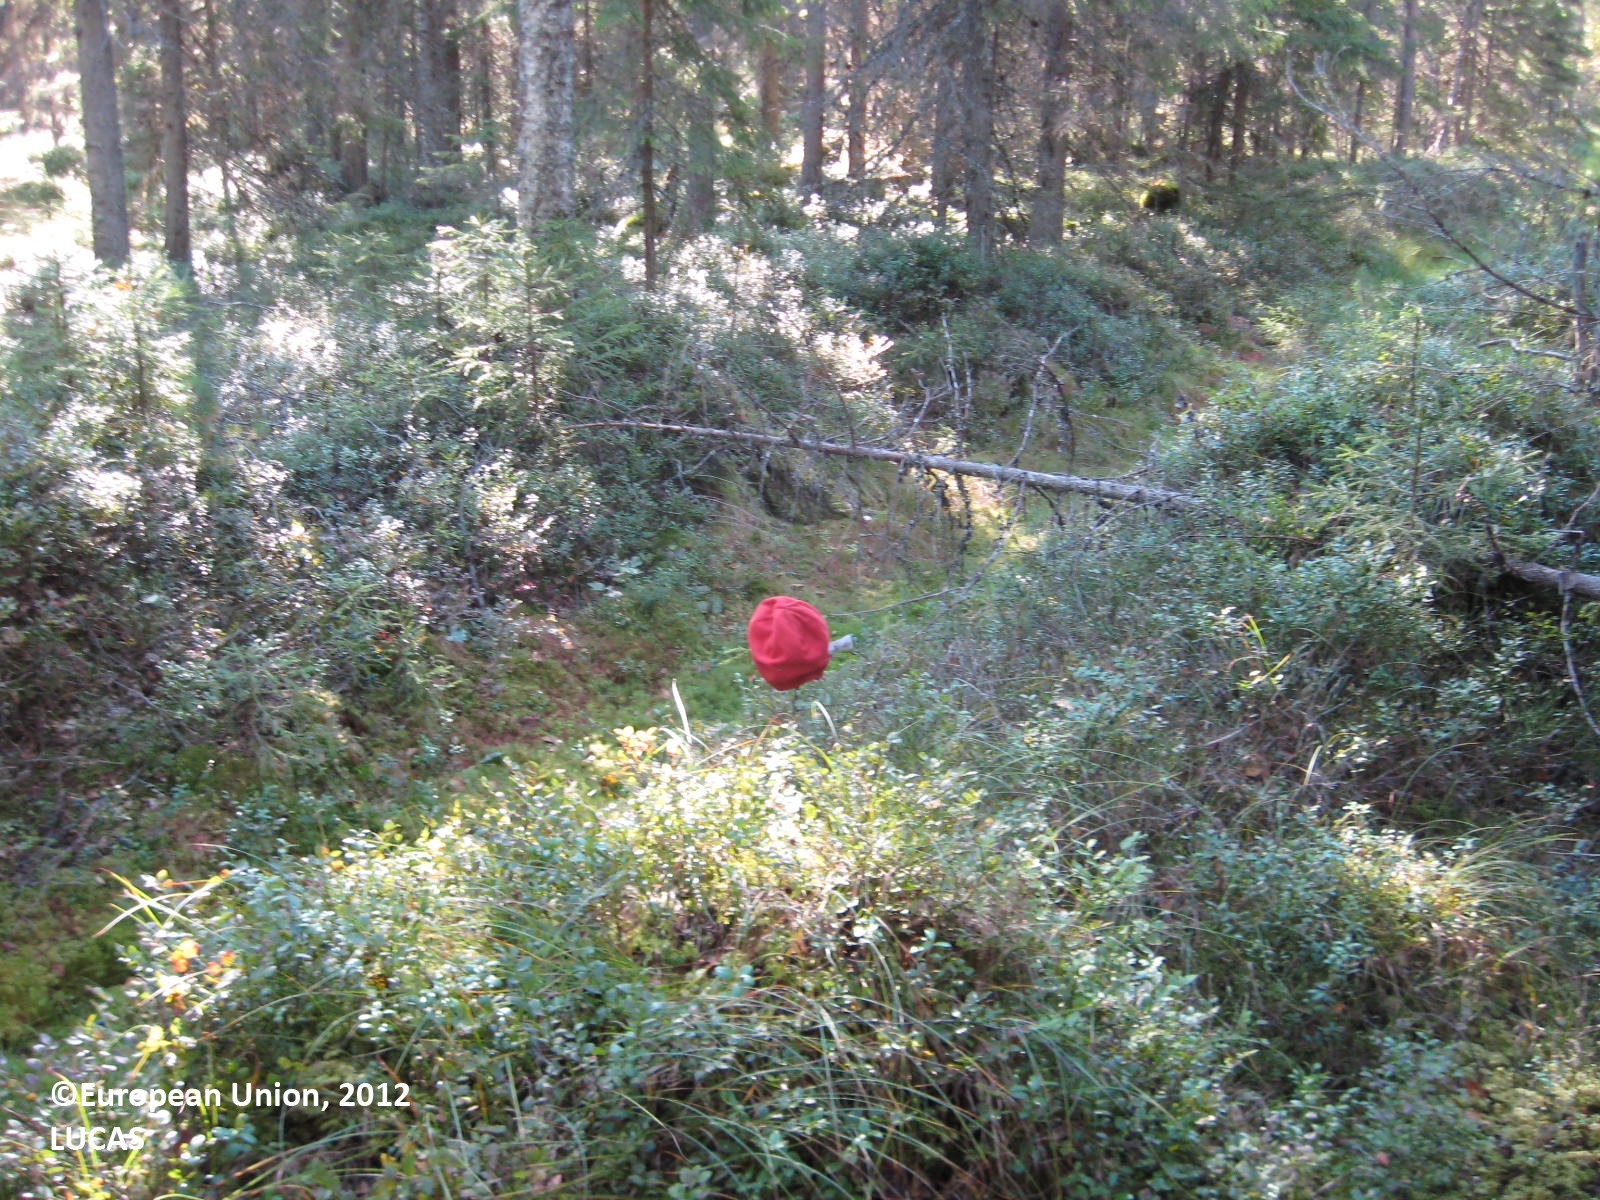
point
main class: Woodland
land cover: Spruce dominated coniferous woodland
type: boreal forest
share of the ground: > 75 %
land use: Forestry
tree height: > 5 m
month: August
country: FI
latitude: 63.7263
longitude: 29.8170
